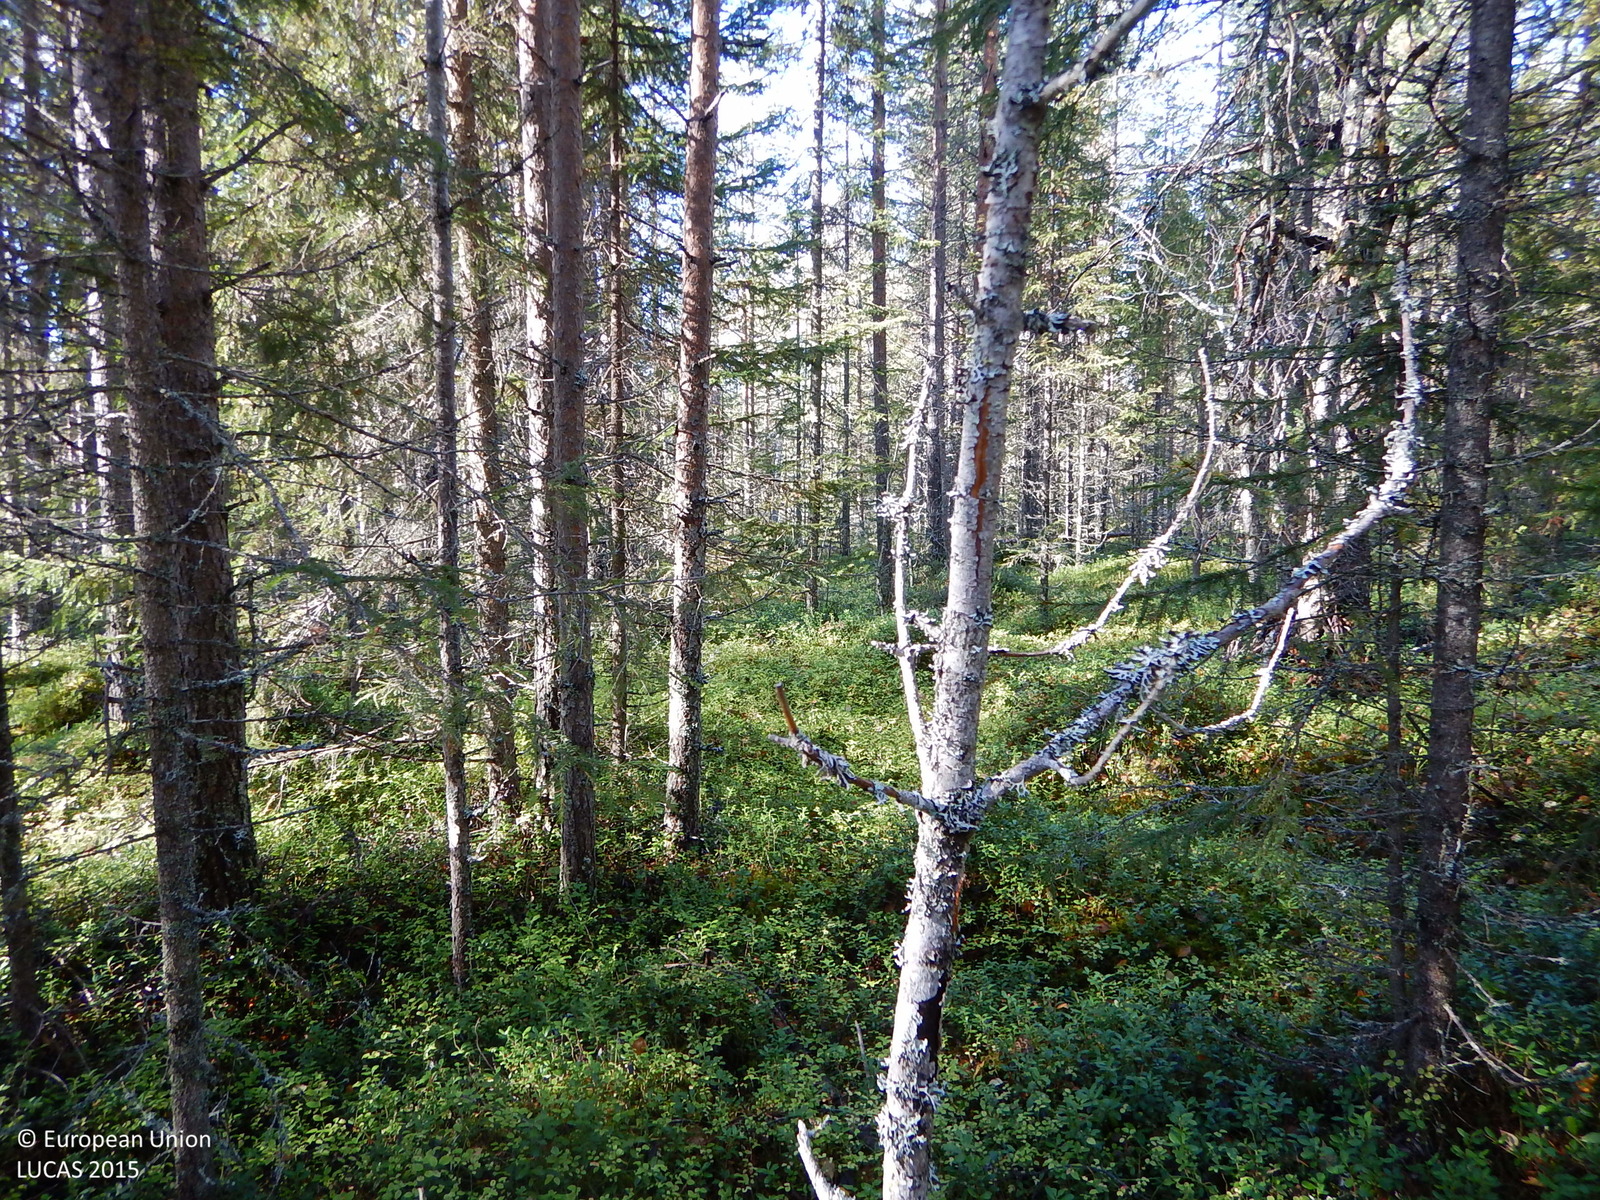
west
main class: Woodland
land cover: Other coniferous woodland
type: boreal forest
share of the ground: 50 - 75 %
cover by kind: coniferous forest trees 70 %, shrubs 15 %, lichens and mosses 10 %, herbaceous plants 5 %
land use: Forestry
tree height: > 5 m
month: September
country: SE
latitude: 64.9504
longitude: 20.1096
